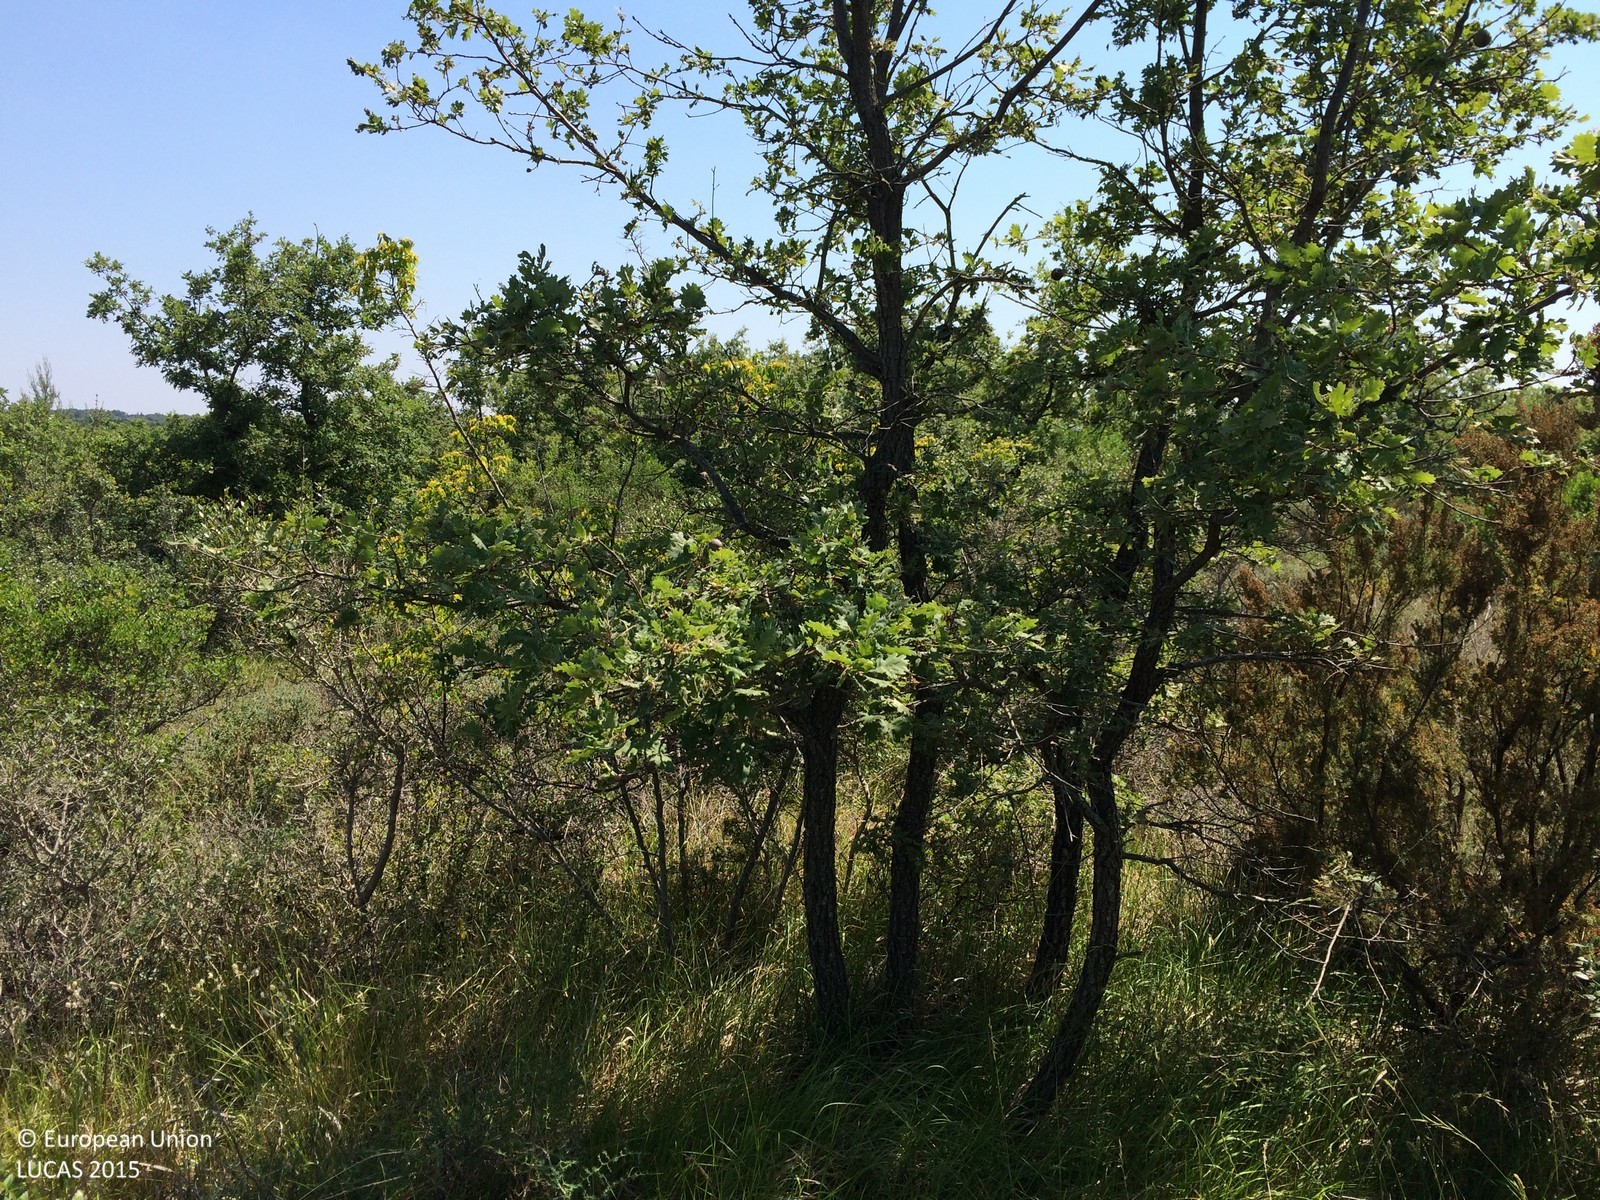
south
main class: Shrubland
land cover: Shrubland with sparse tree cover
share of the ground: > 75 %
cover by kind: shrubs 90 %, broadleaved forest trees 5 %, herbaceous plants 5 %
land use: Semi-natural and natural areas not in use
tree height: < 5 m
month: June
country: HR
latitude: 45.0025
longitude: 13.8130
